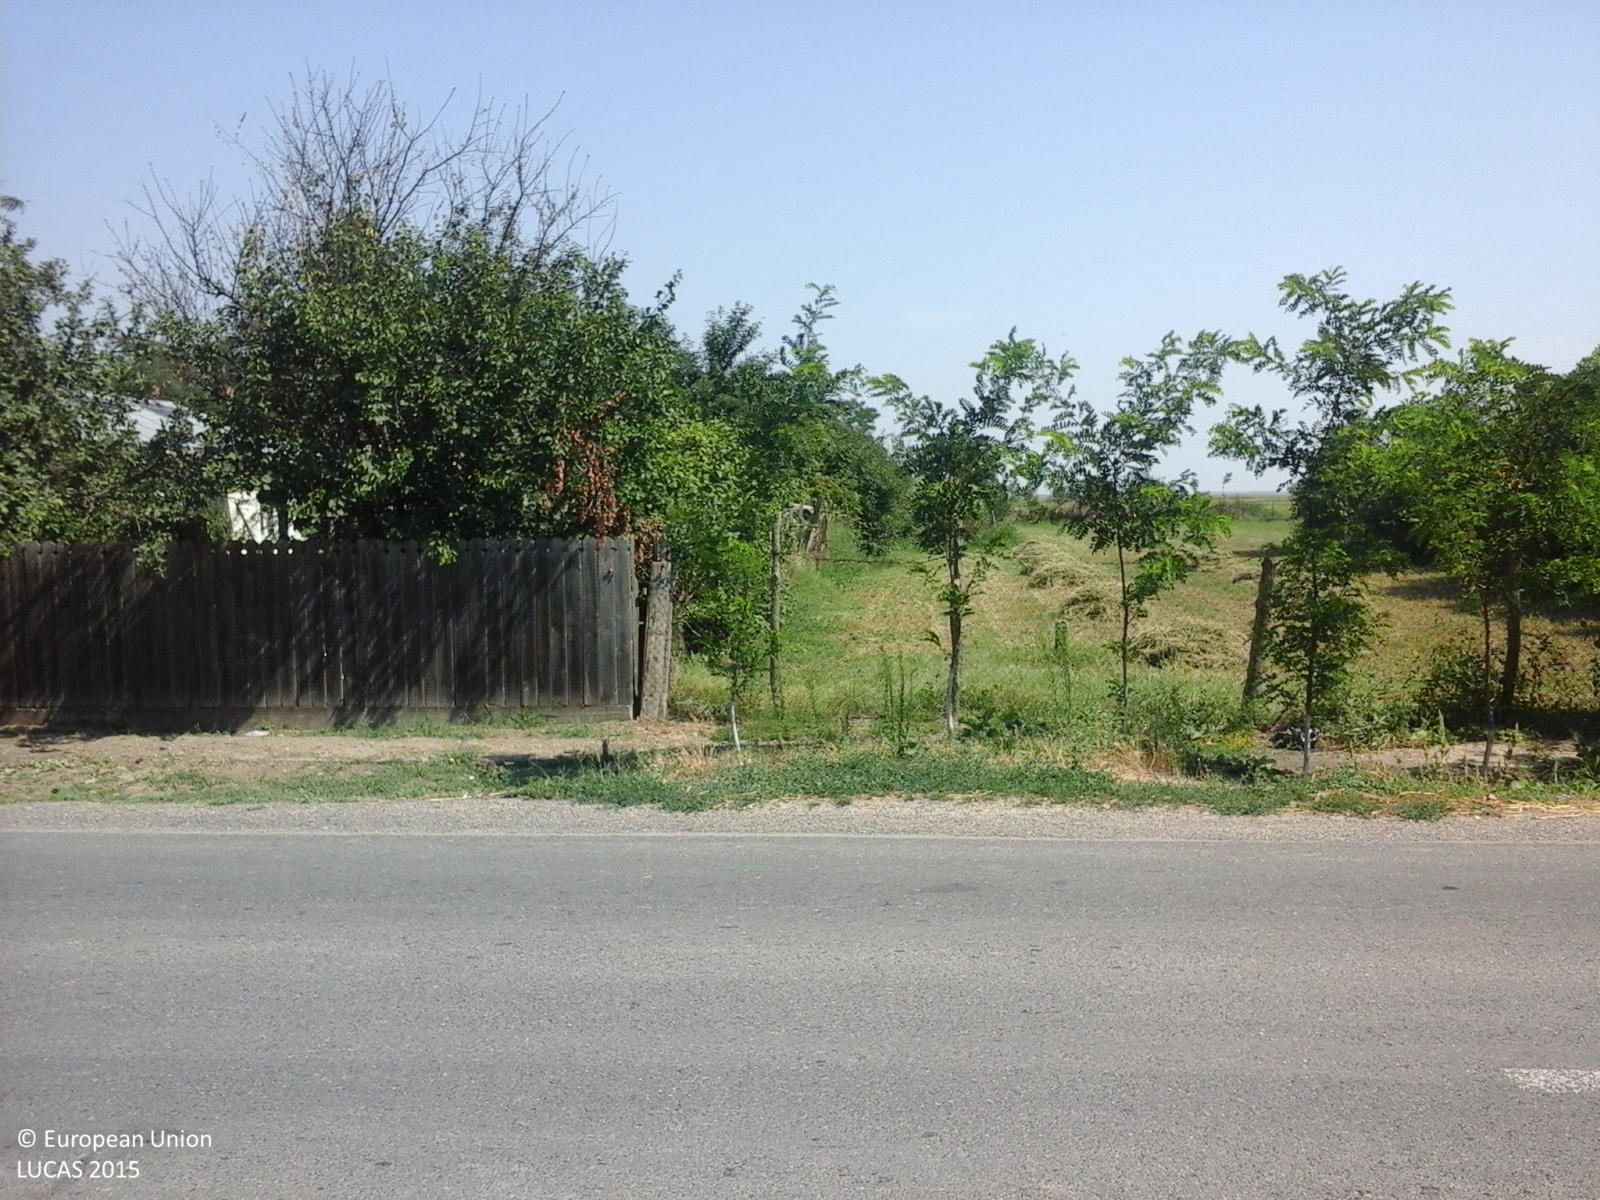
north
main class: Cropland
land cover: Maize
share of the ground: > 75 %
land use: Agriculture (excluding fallow land and kitchen gardens)
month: August
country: RO
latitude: 45.4116
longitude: 27.5970
